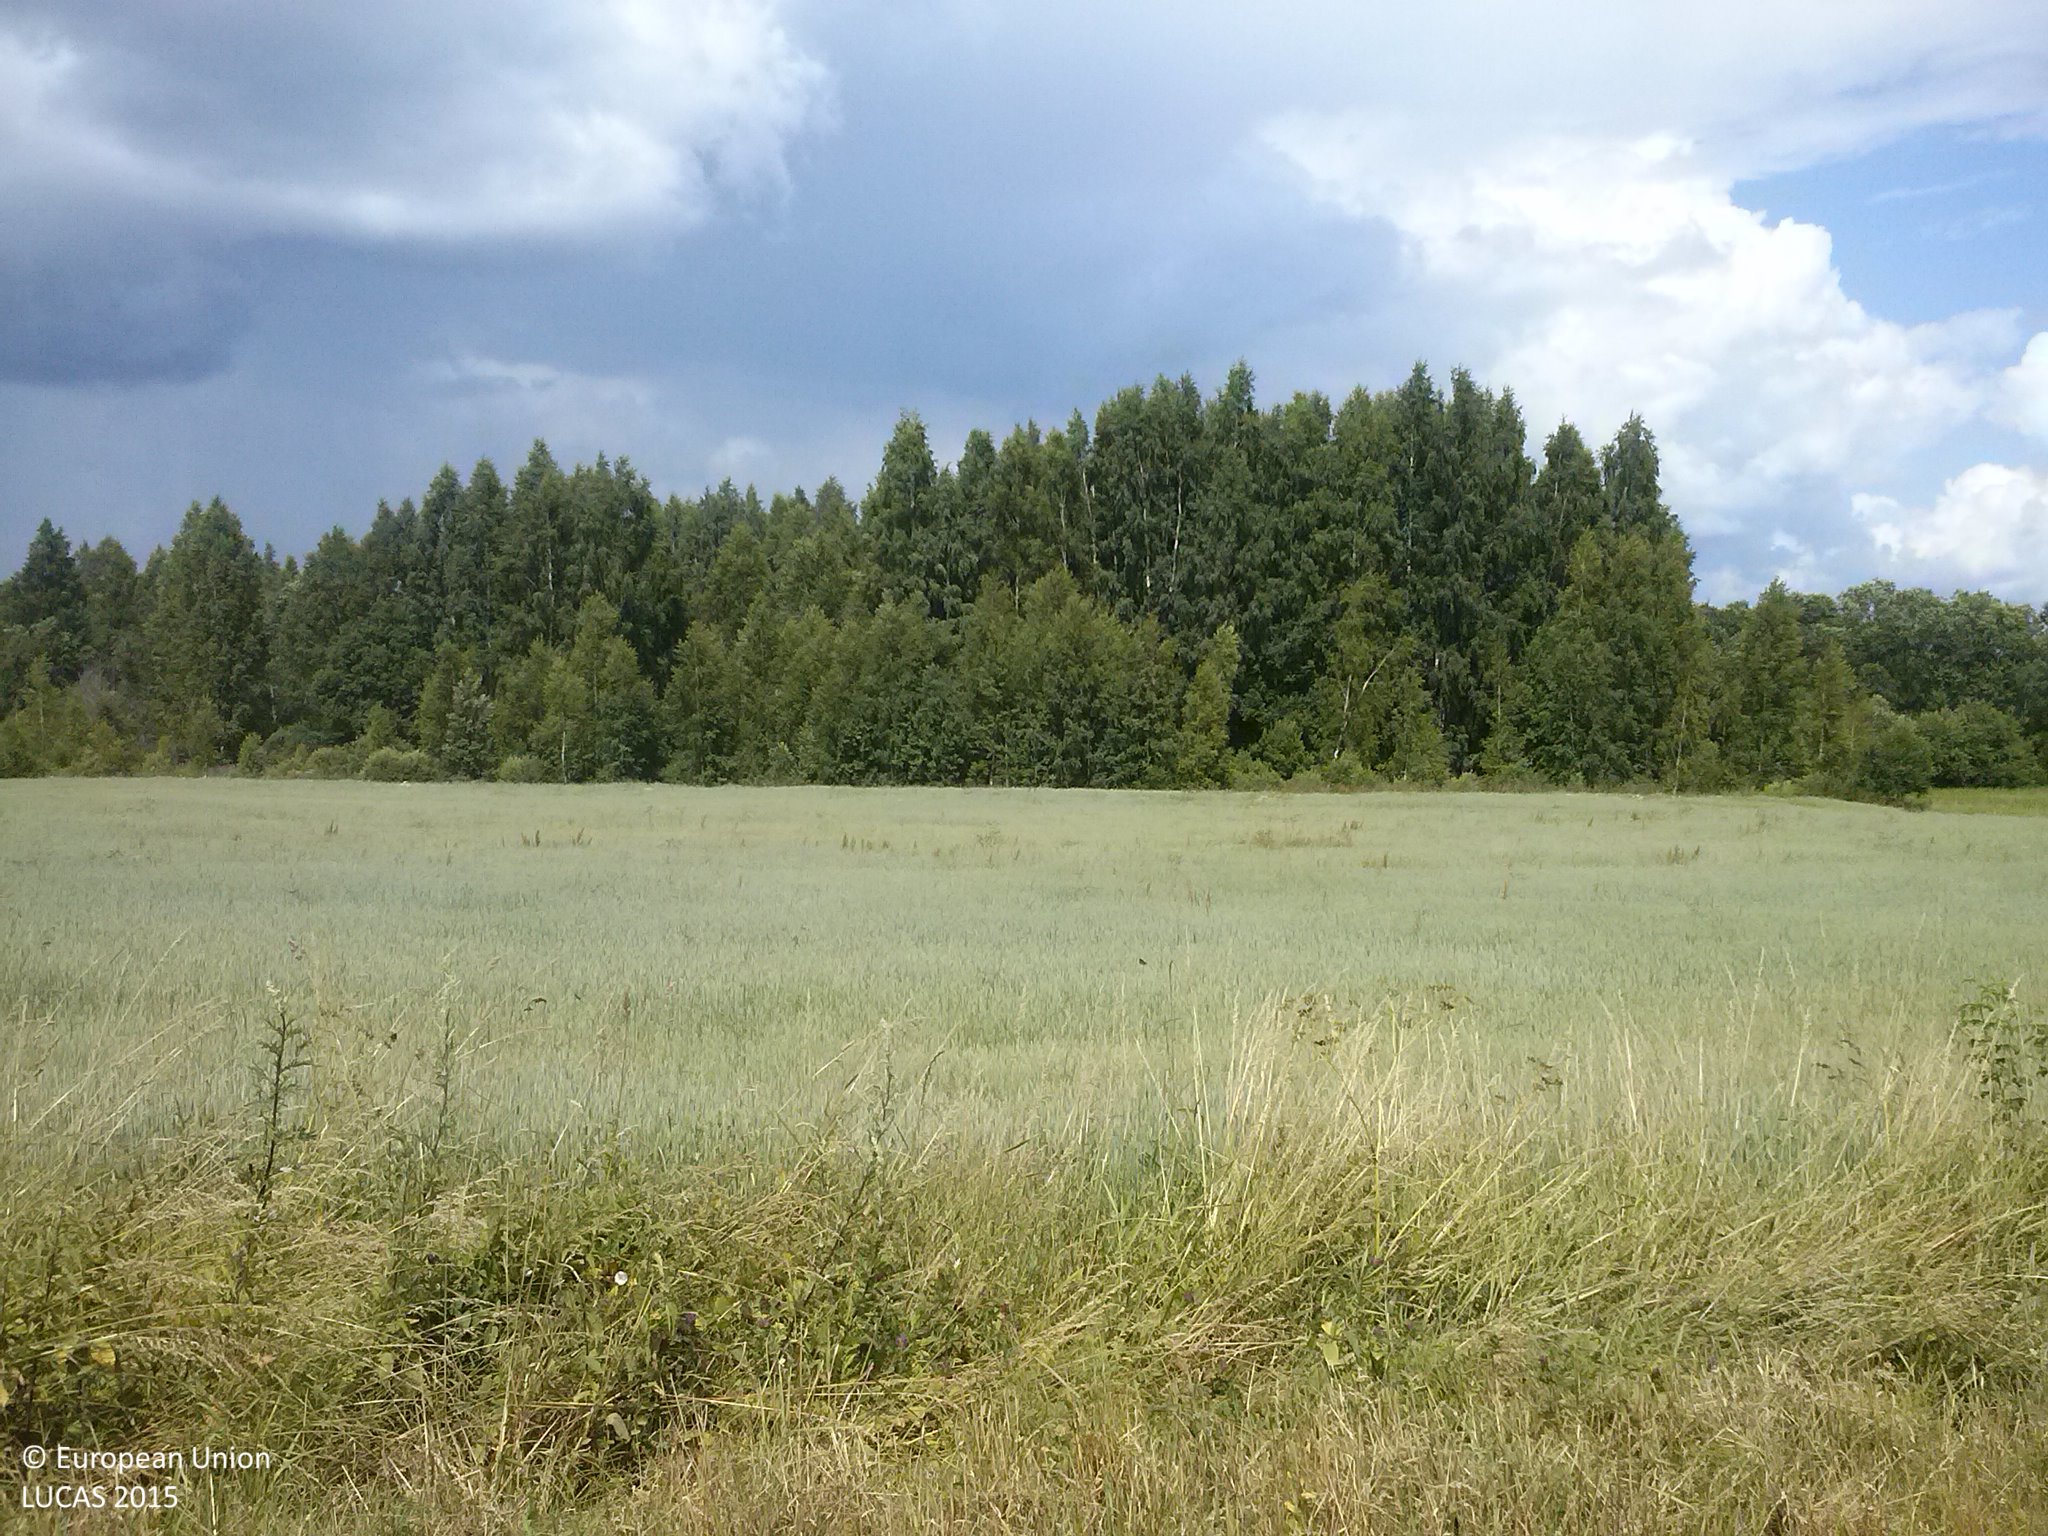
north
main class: Cropland
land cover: Durum wheat
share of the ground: > 75 %
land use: Agriculture (excluding fallow land and kitchen gardens)
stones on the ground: < 10 %
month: July
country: LV
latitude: 56.7176
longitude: 27.5482
